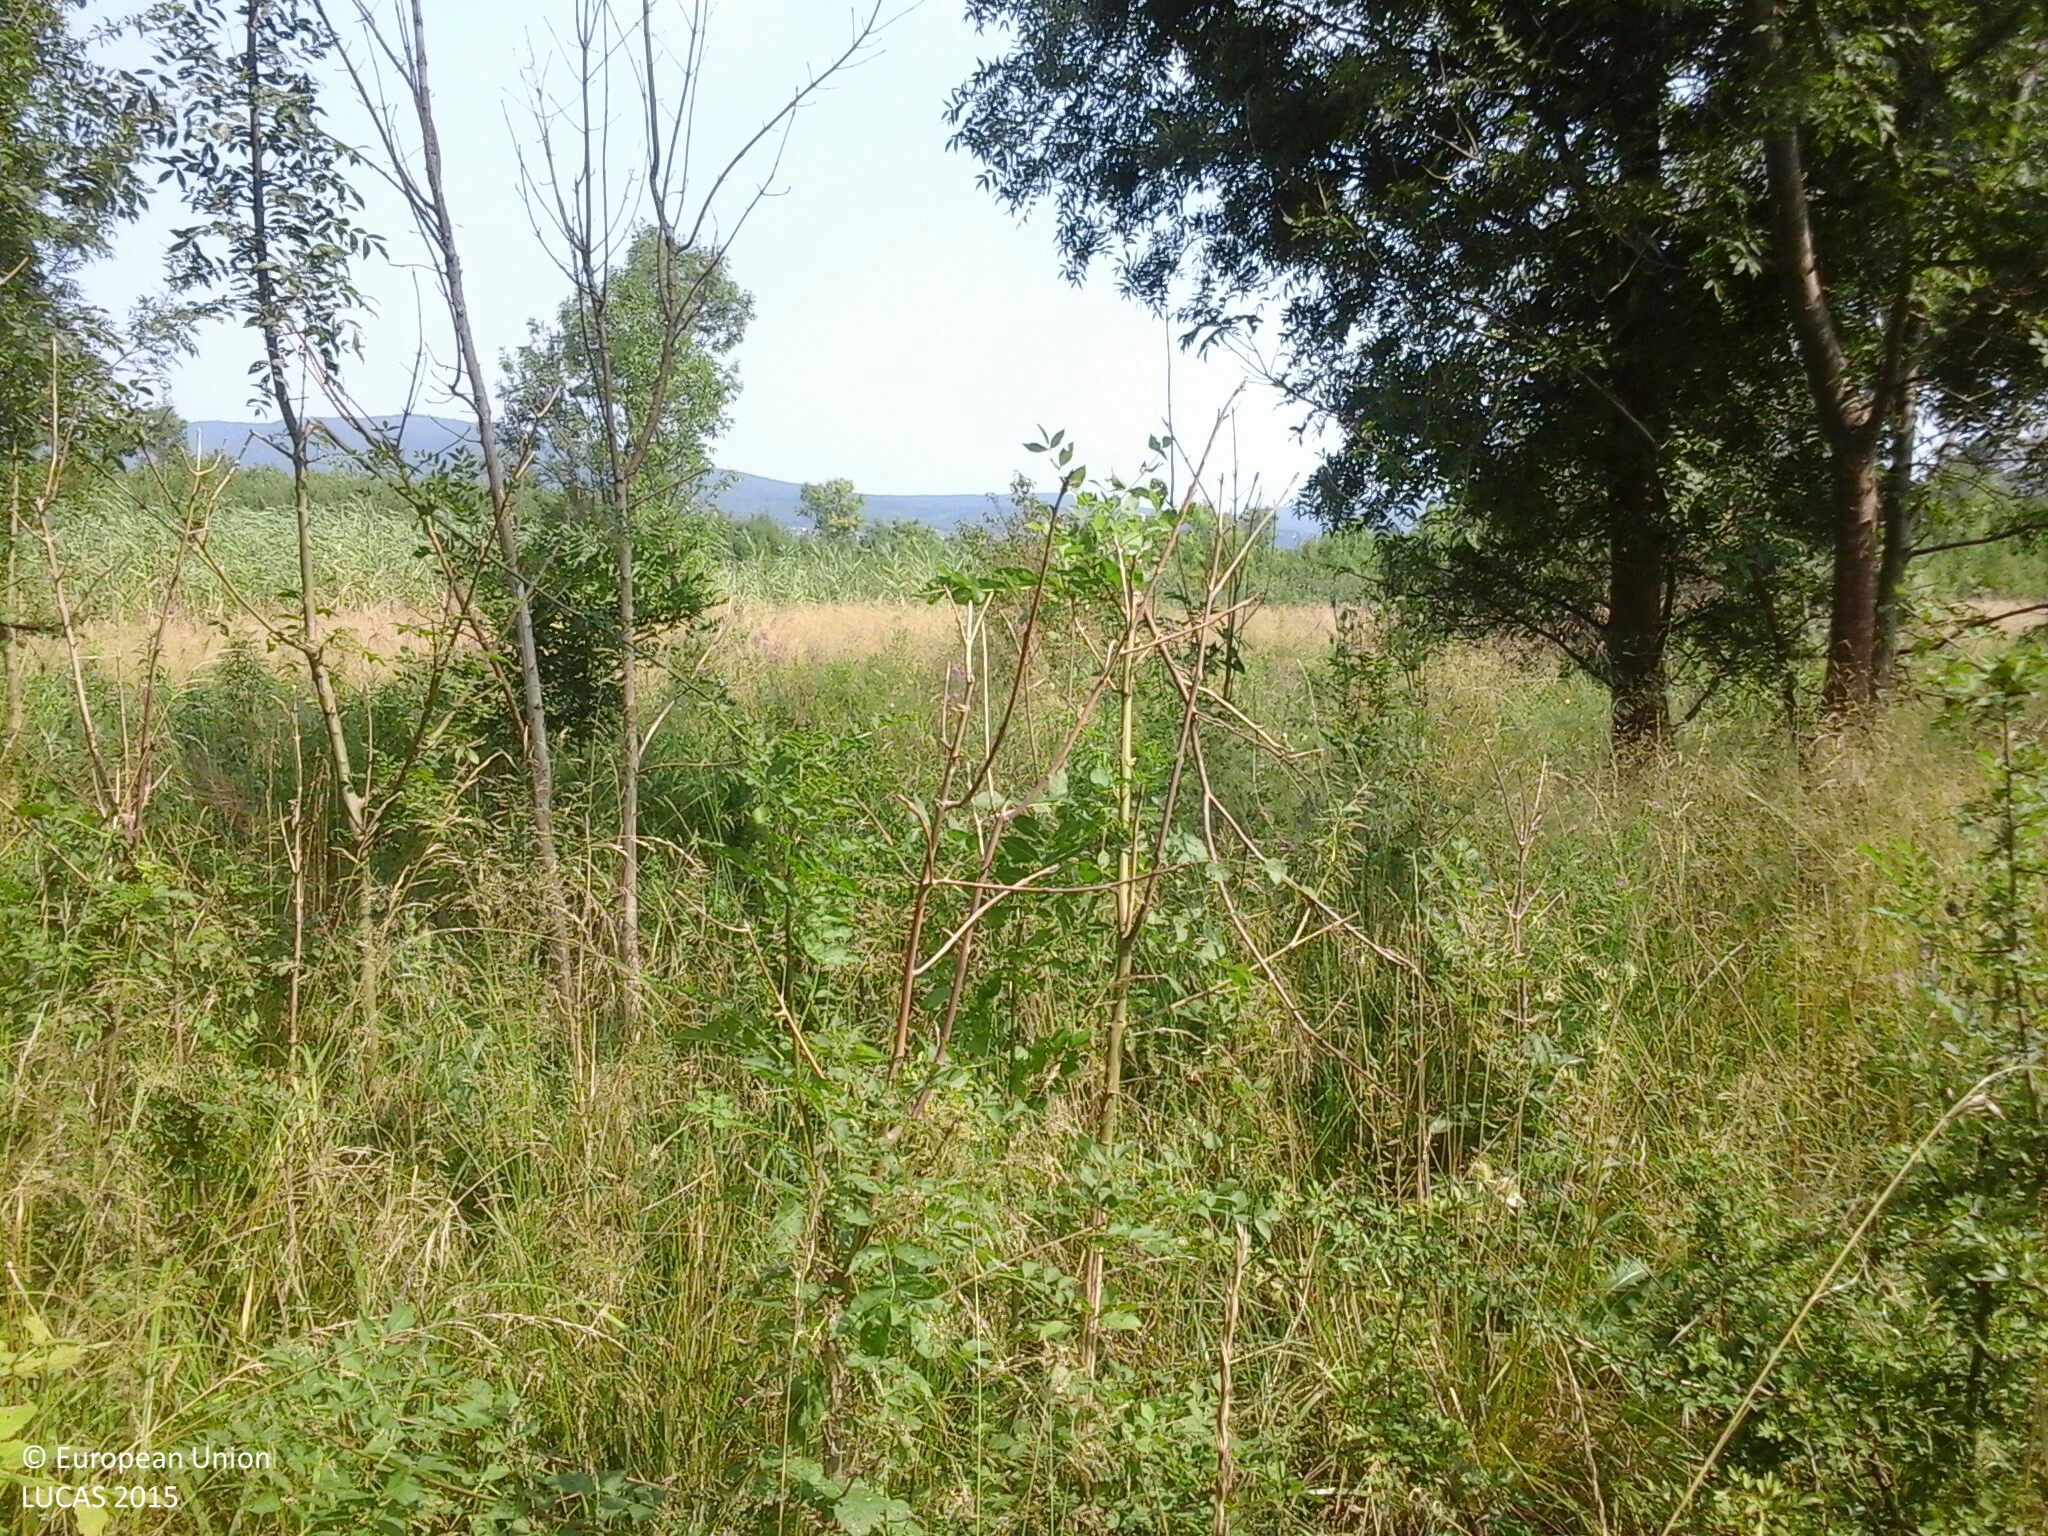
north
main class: Woodland
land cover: Broadleaved woodland
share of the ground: 25 - 50 %
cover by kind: herbaceous plants 60 %, broadleaved forest trees 40 %
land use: Abandoned areas
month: August
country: HU
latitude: 46.0391
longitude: 18.1601
